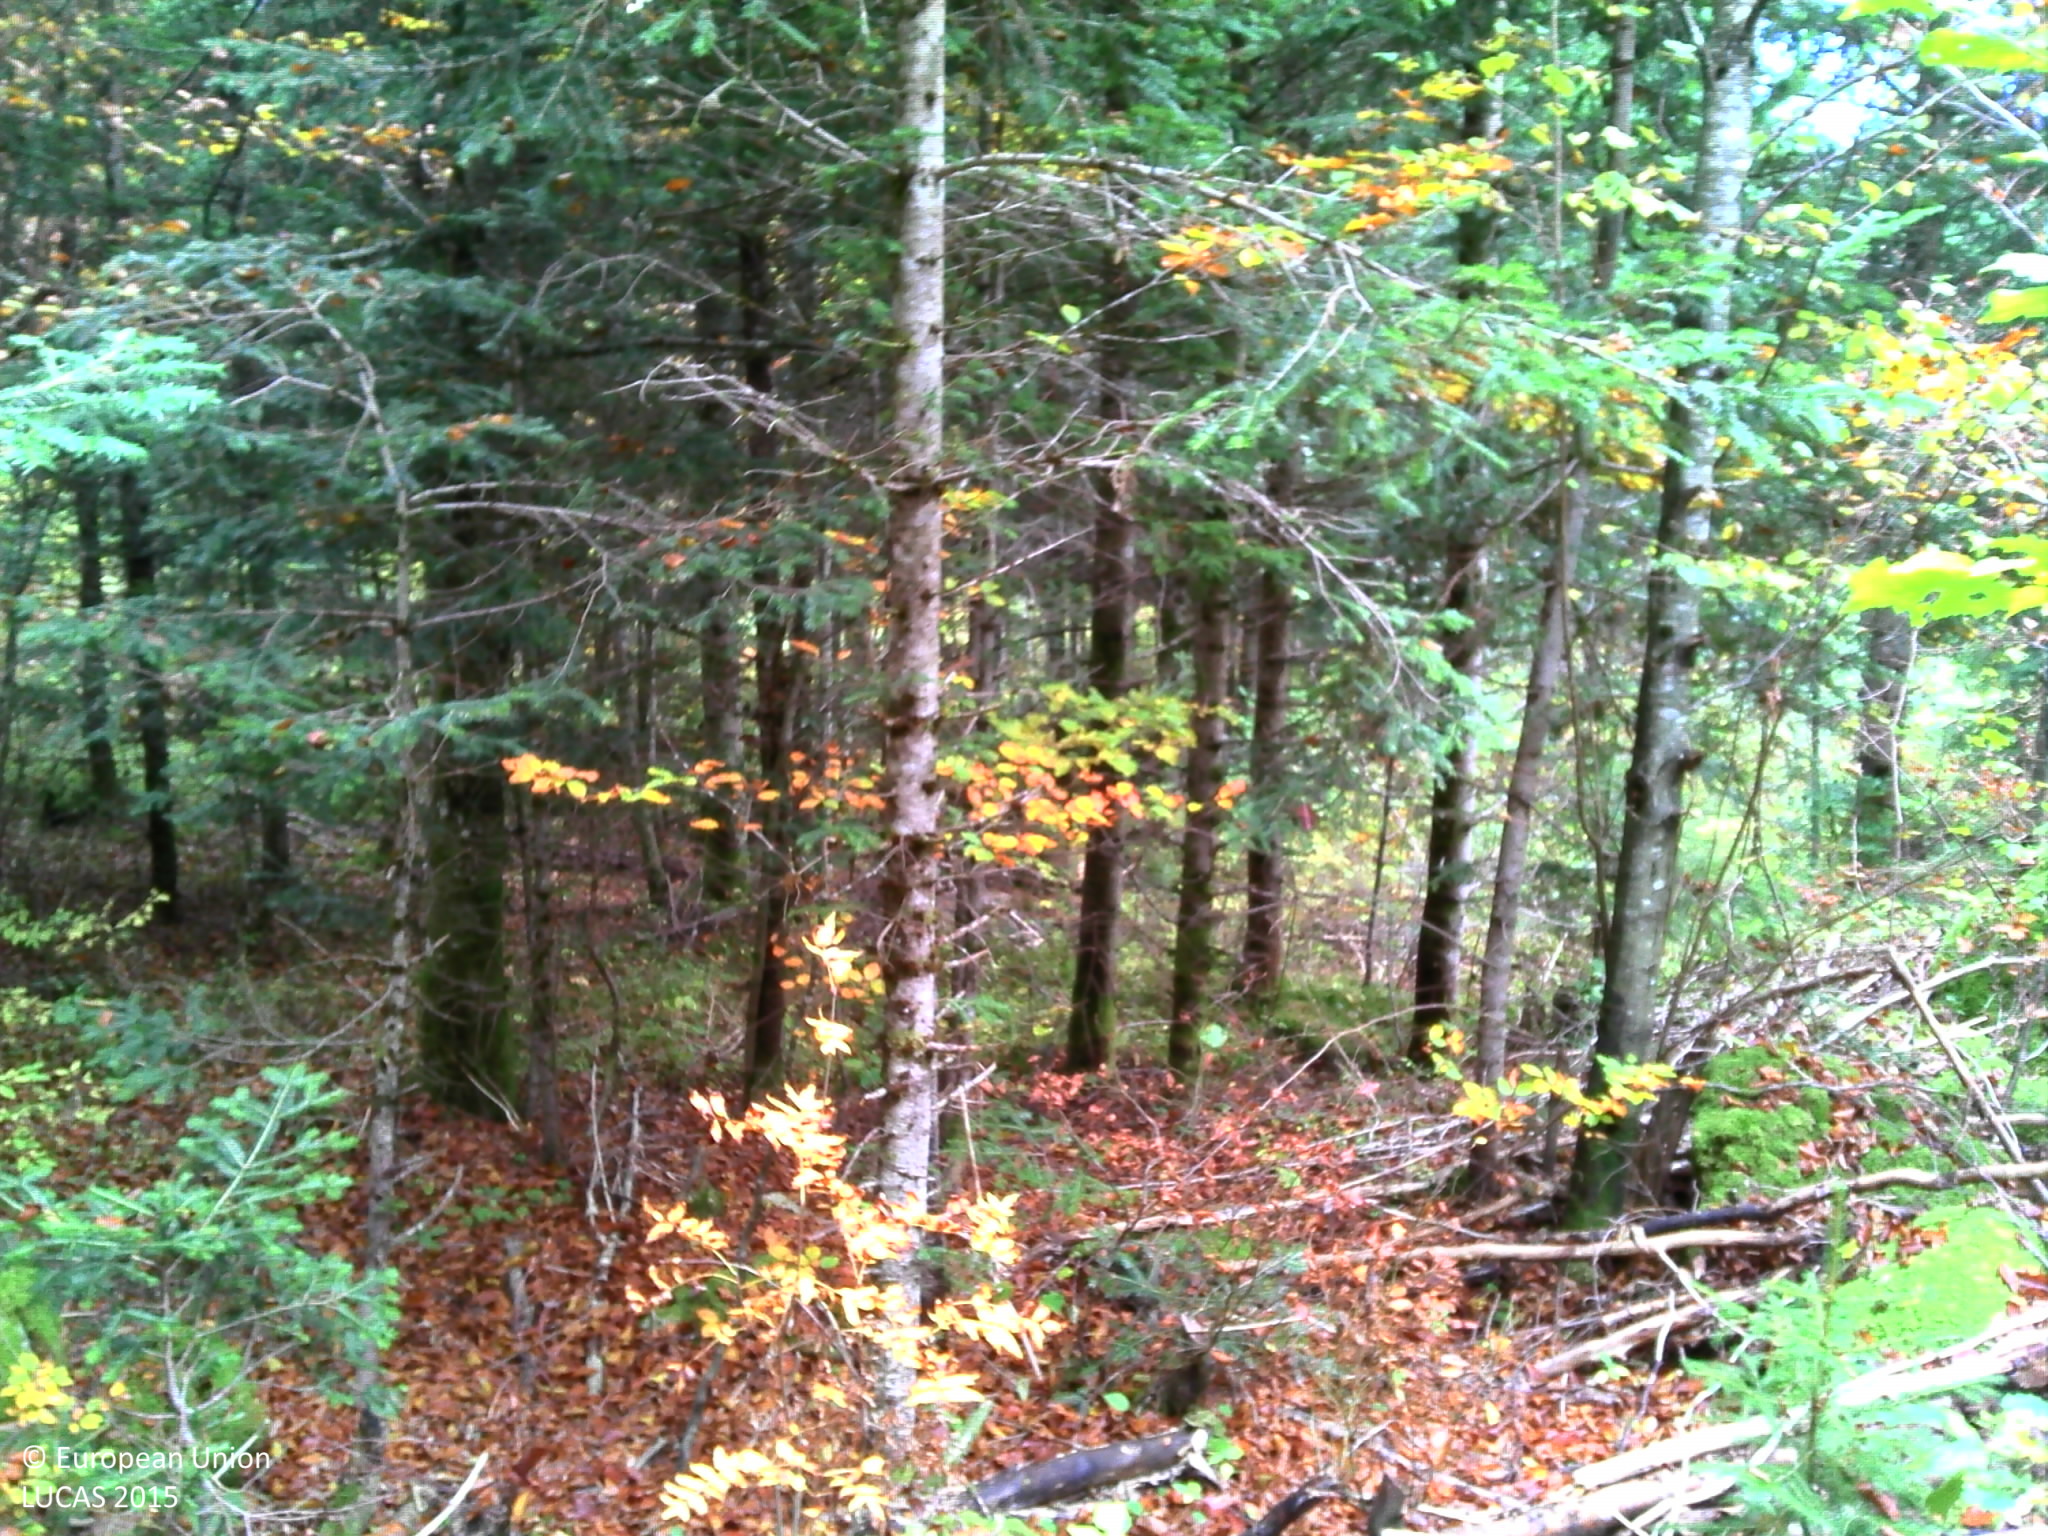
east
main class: Woodland
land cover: Spruce dominated mixed woodland
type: mountainous beech forest
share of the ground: > 75 %
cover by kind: coniferous forest trees 40 %, broadleaved forest trees 40 %, unconsolidated bare surface 10 %, lichens and mosses 5 %, consolidated bare surface 5 %
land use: Forestry
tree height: > 5 m
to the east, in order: Spruce dominated mixed woodland; Tracks; Spruce dominated mixed woodland; Tracks; Spruce dominated mixed woodland; Tracks; Spruce dominated mixed woodland; Tracks; Spruce dominated mixed woodland; Tracks; Spruce dominated mixed woodland; Dry stone walls; Tracks; Spruce dominated mixed woodland
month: October
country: FR
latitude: 46.6964
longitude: 6.1448
